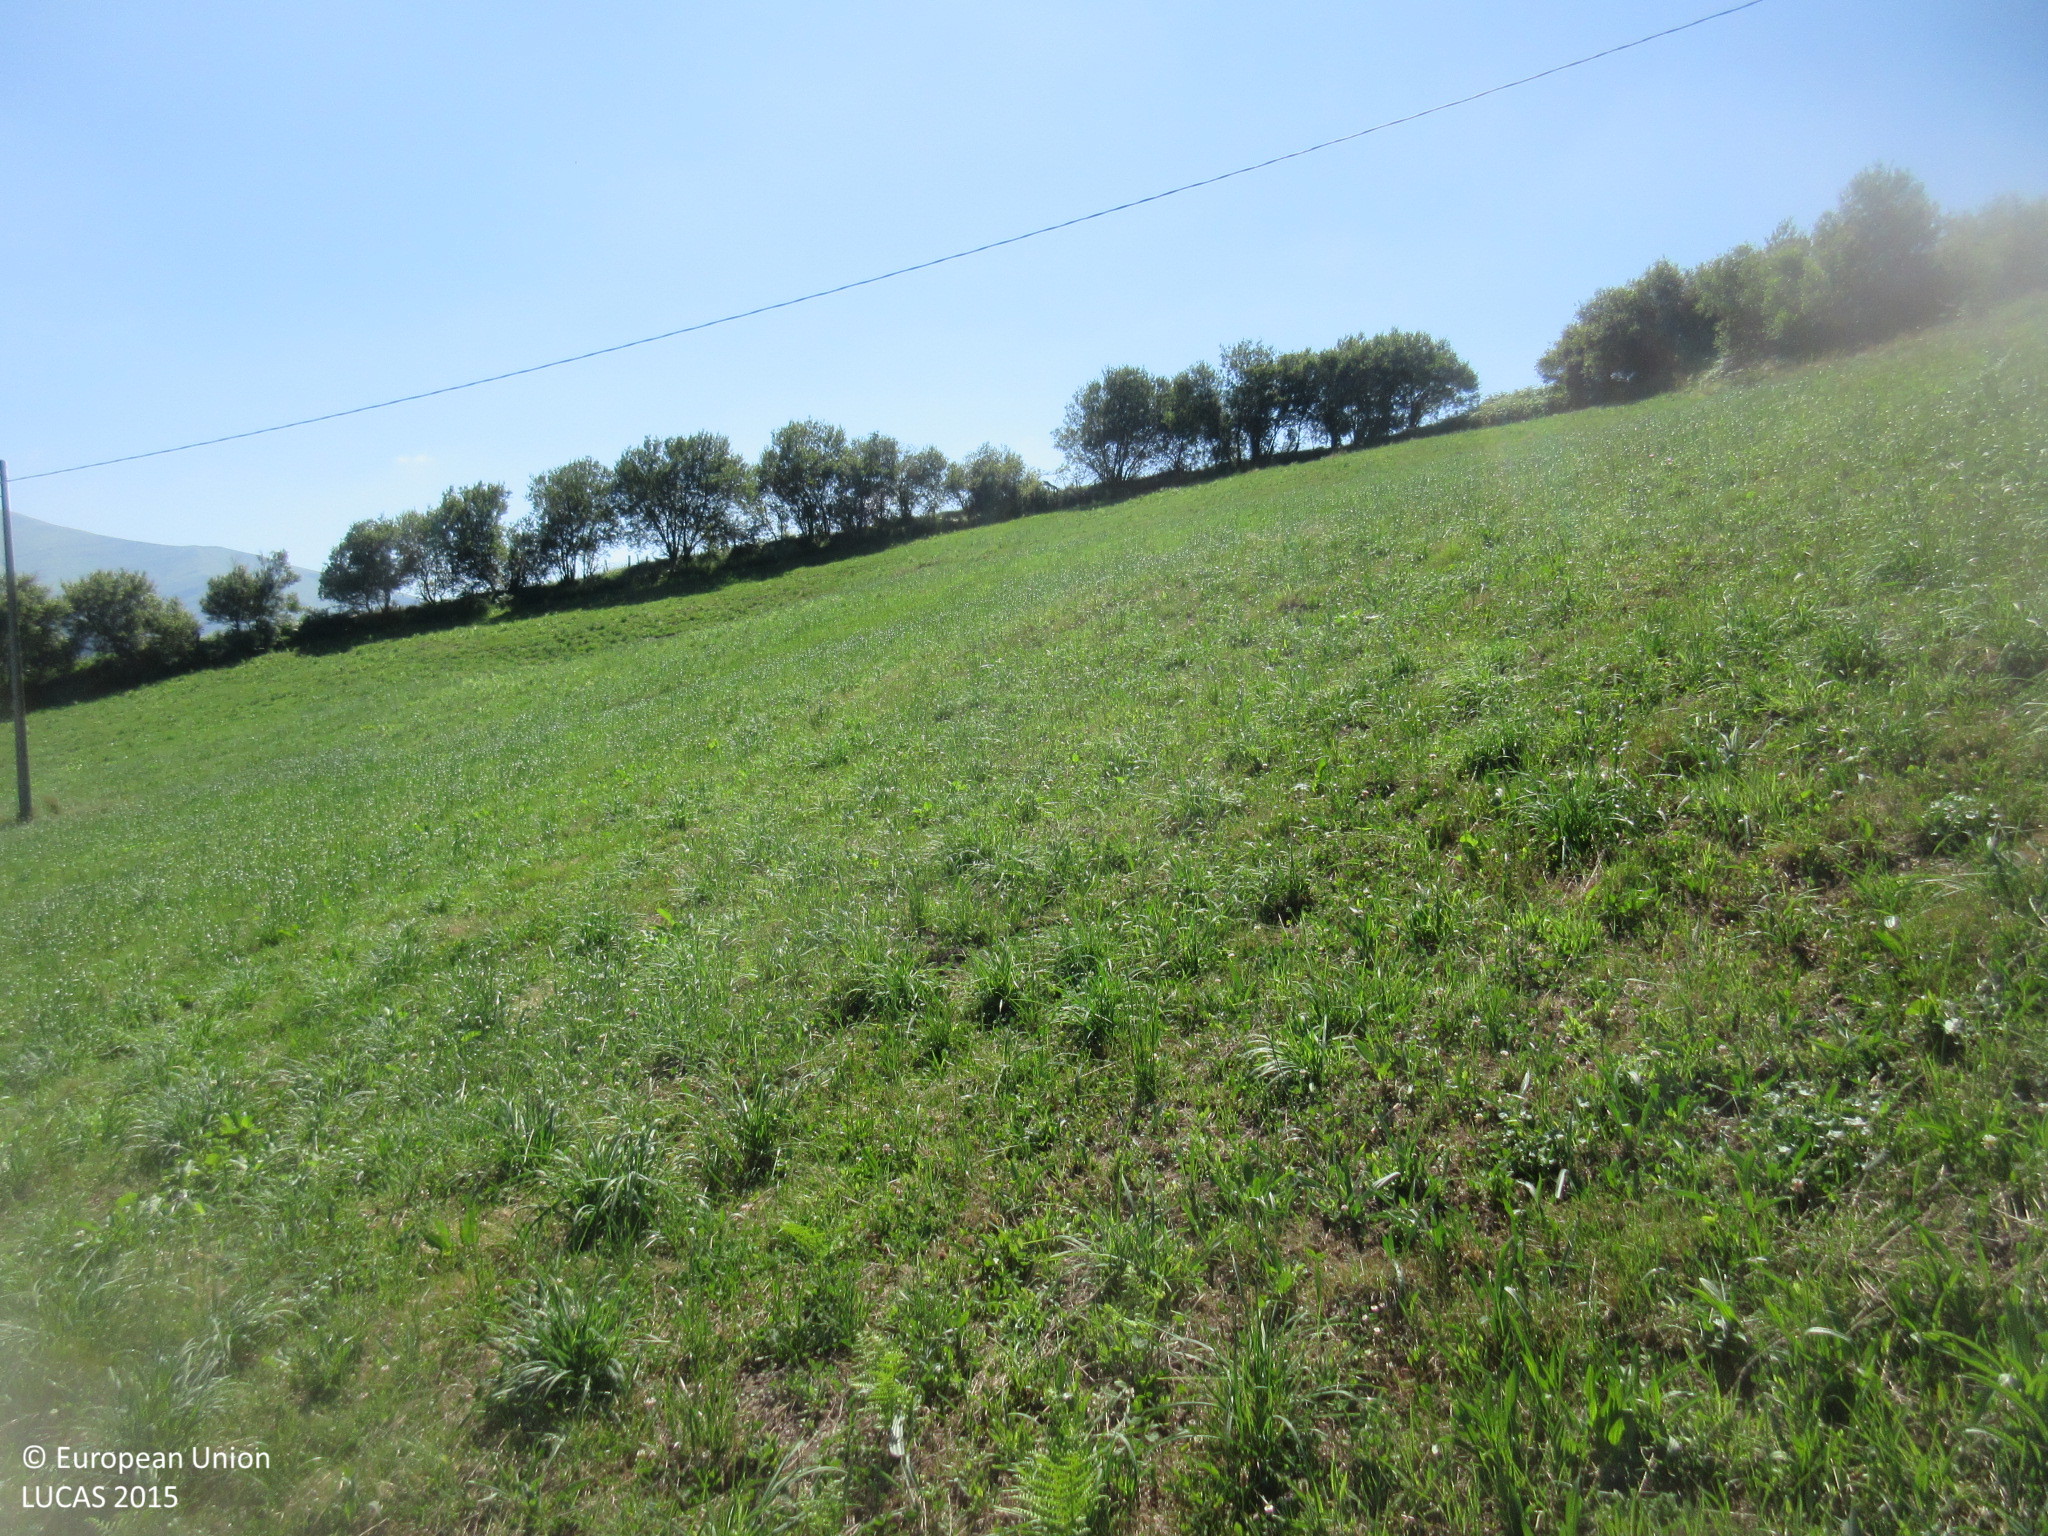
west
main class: Grassland
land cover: Grassland without tree/shrub cover
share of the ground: > 75 %
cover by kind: herbaceous plants 100 %
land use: Agriculture (excluding fallow land and kitchen gardens)
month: July
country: ES
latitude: 43.1860
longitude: -3.3898
